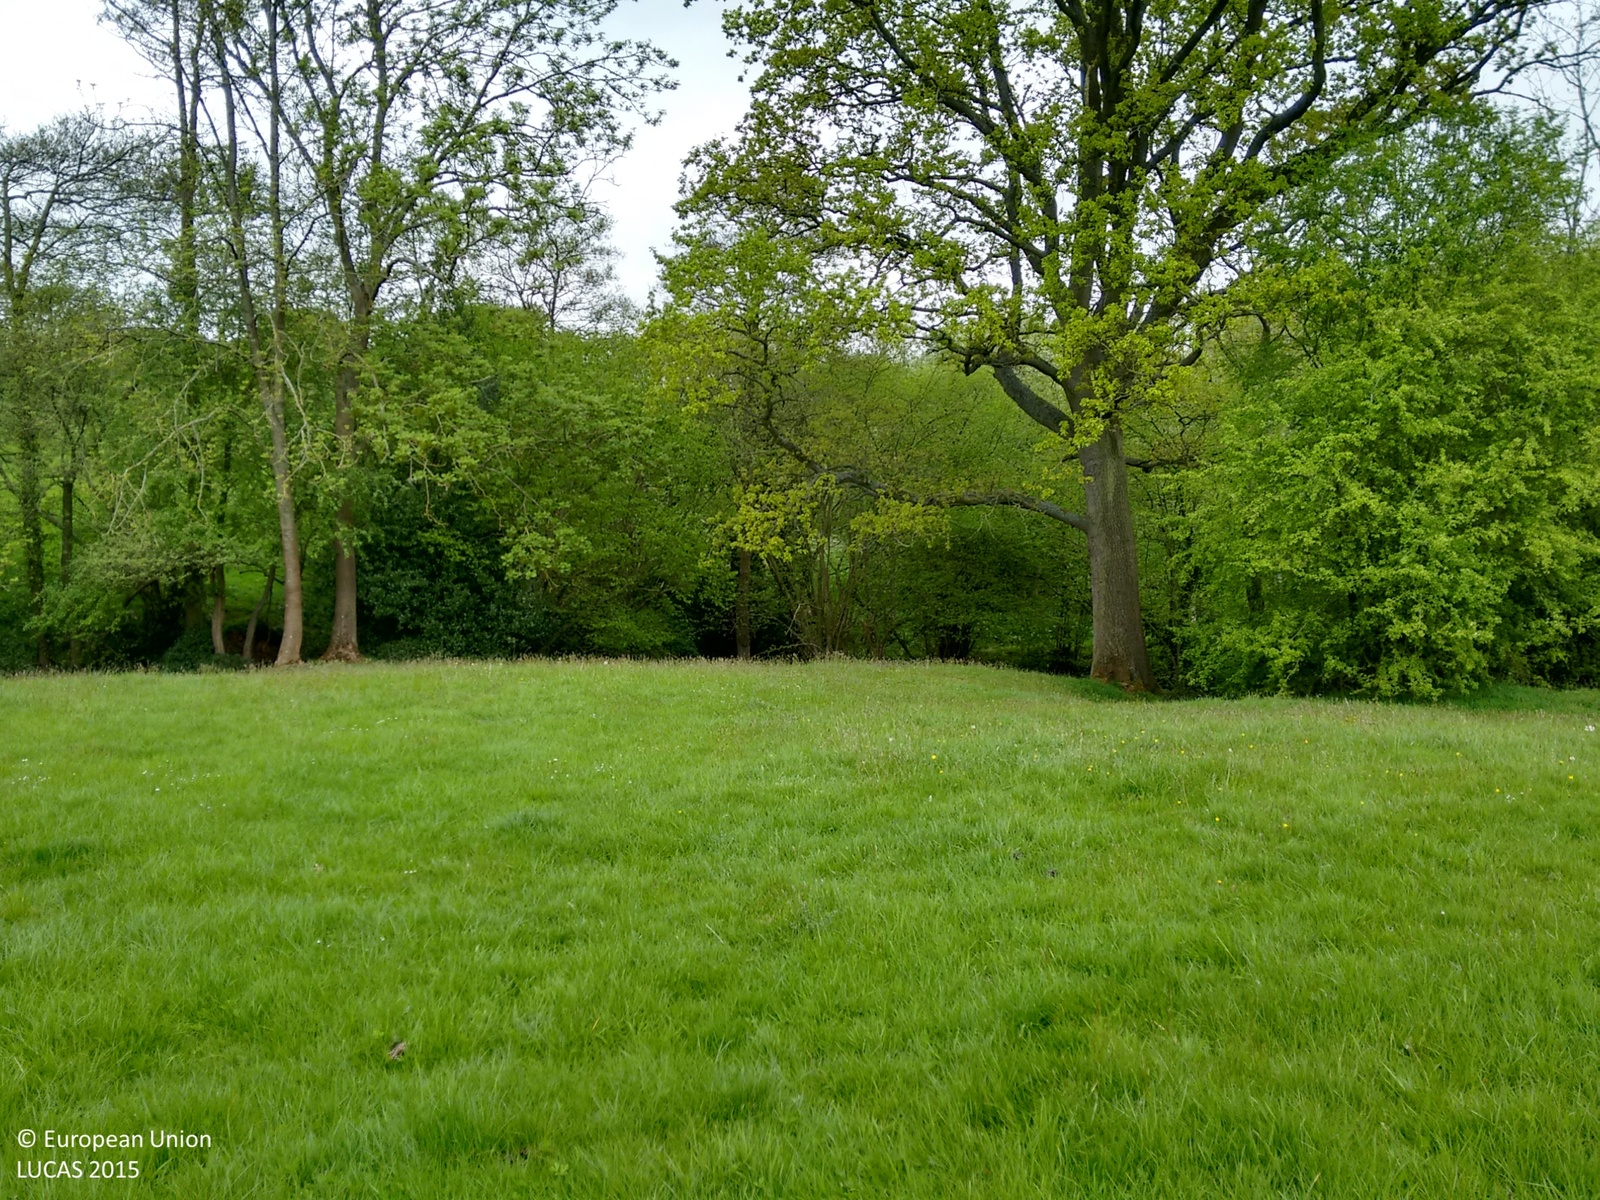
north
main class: Grassland
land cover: Grassland without tree/shrub cover
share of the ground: > 75 %
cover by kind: herbaceous plants 100 %
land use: Agriculture (excluding fallow land and kitchen gardens)
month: May
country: GB
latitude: 52.2974
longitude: -2.4860
